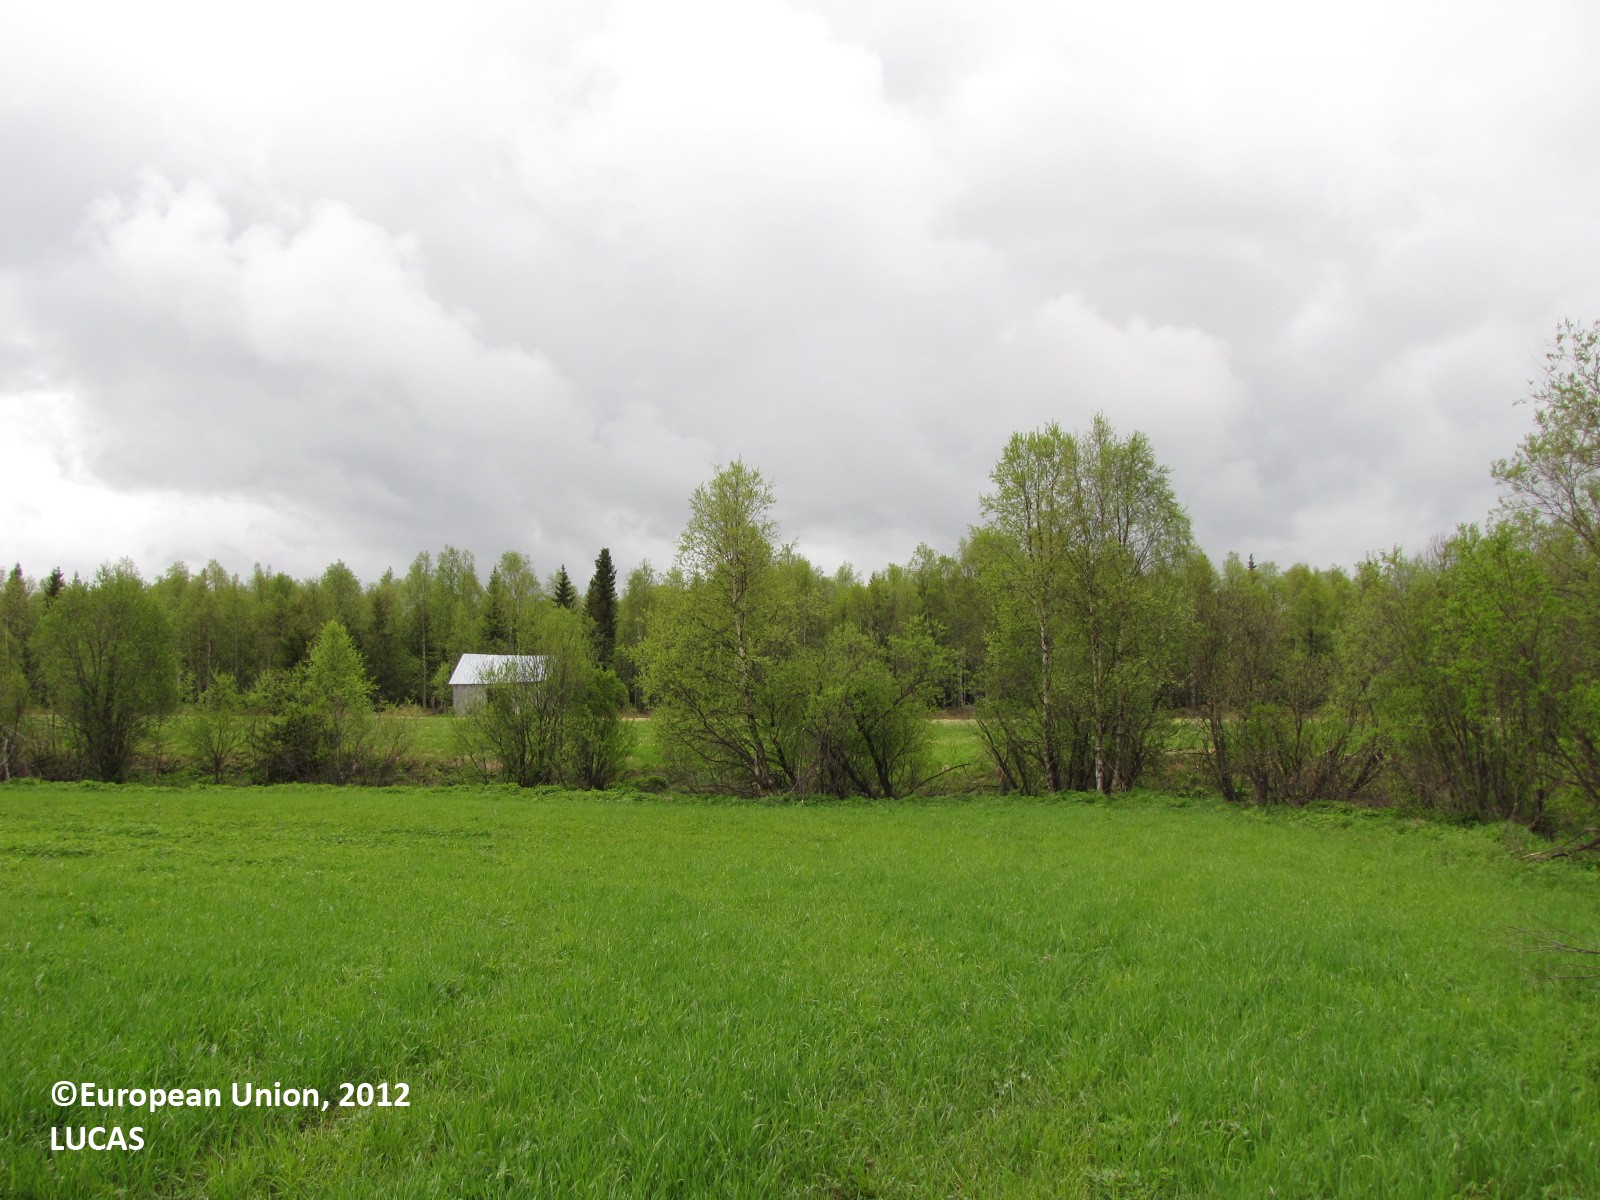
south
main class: Grassland
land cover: Grassland without tree/shrub cover
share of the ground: > 75 %
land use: Agriculture (excluding fallow land and kitchen gardens)
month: June
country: FI
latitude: 65.9492
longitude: 24.4094
